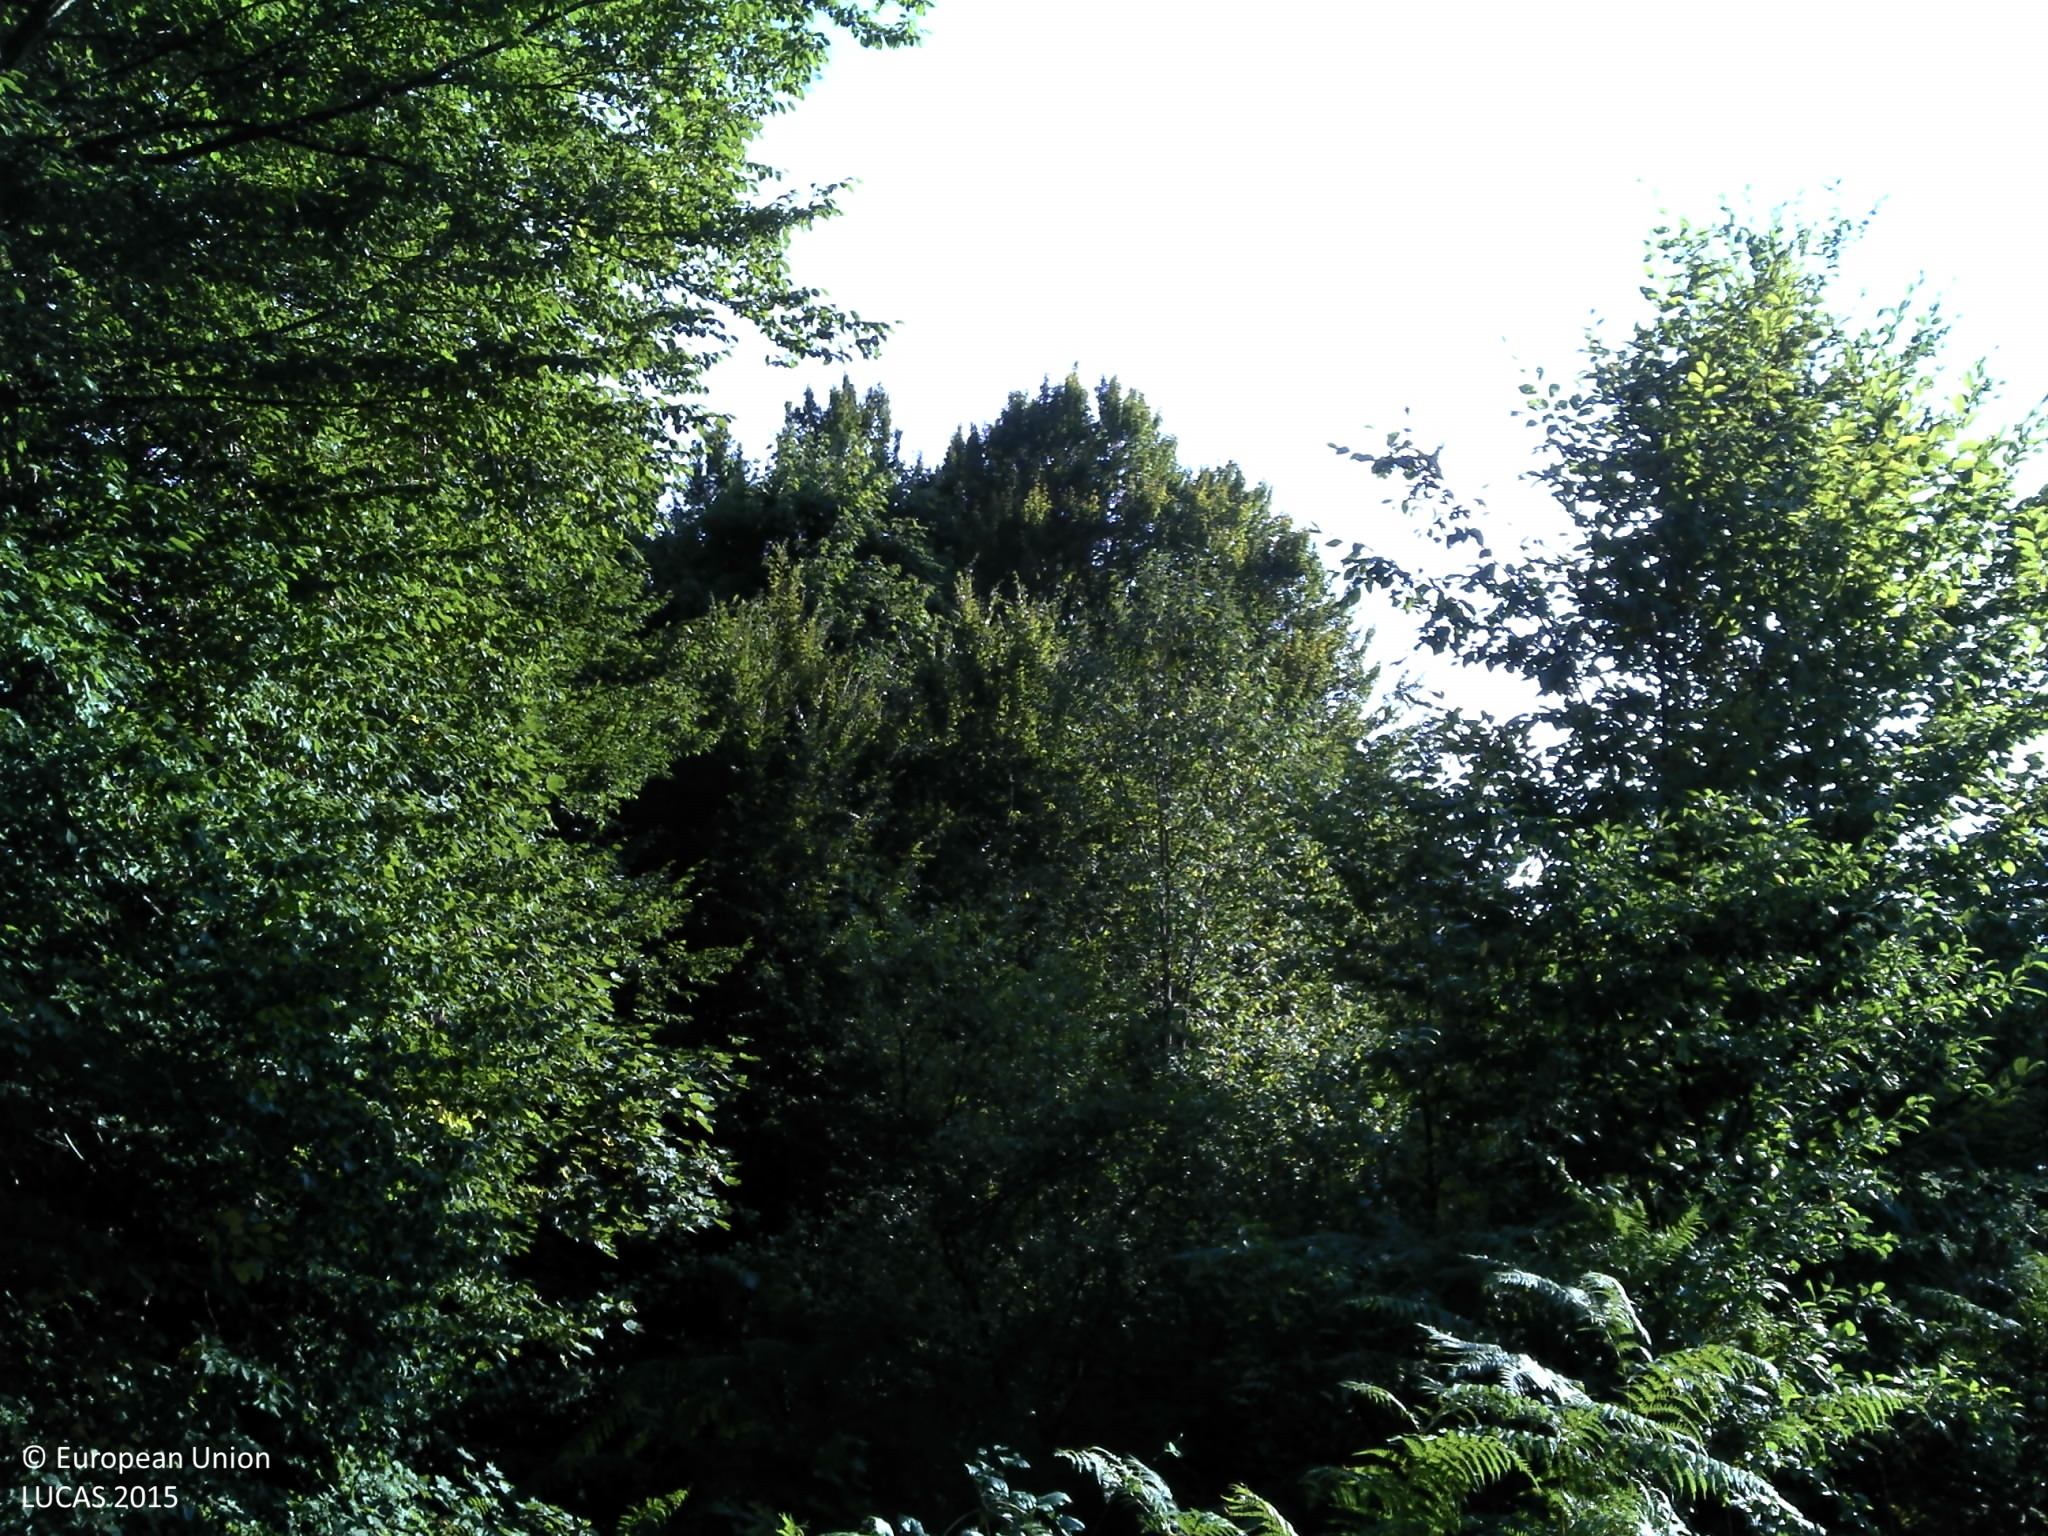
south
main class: Shrubland
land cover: Shrubland without tree cover
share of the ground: > 75 %
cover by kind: shrubs 100 %
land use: Semi-natural and natural areas not in use
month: September
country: HR
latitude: 45.0629
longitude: 15.6720
